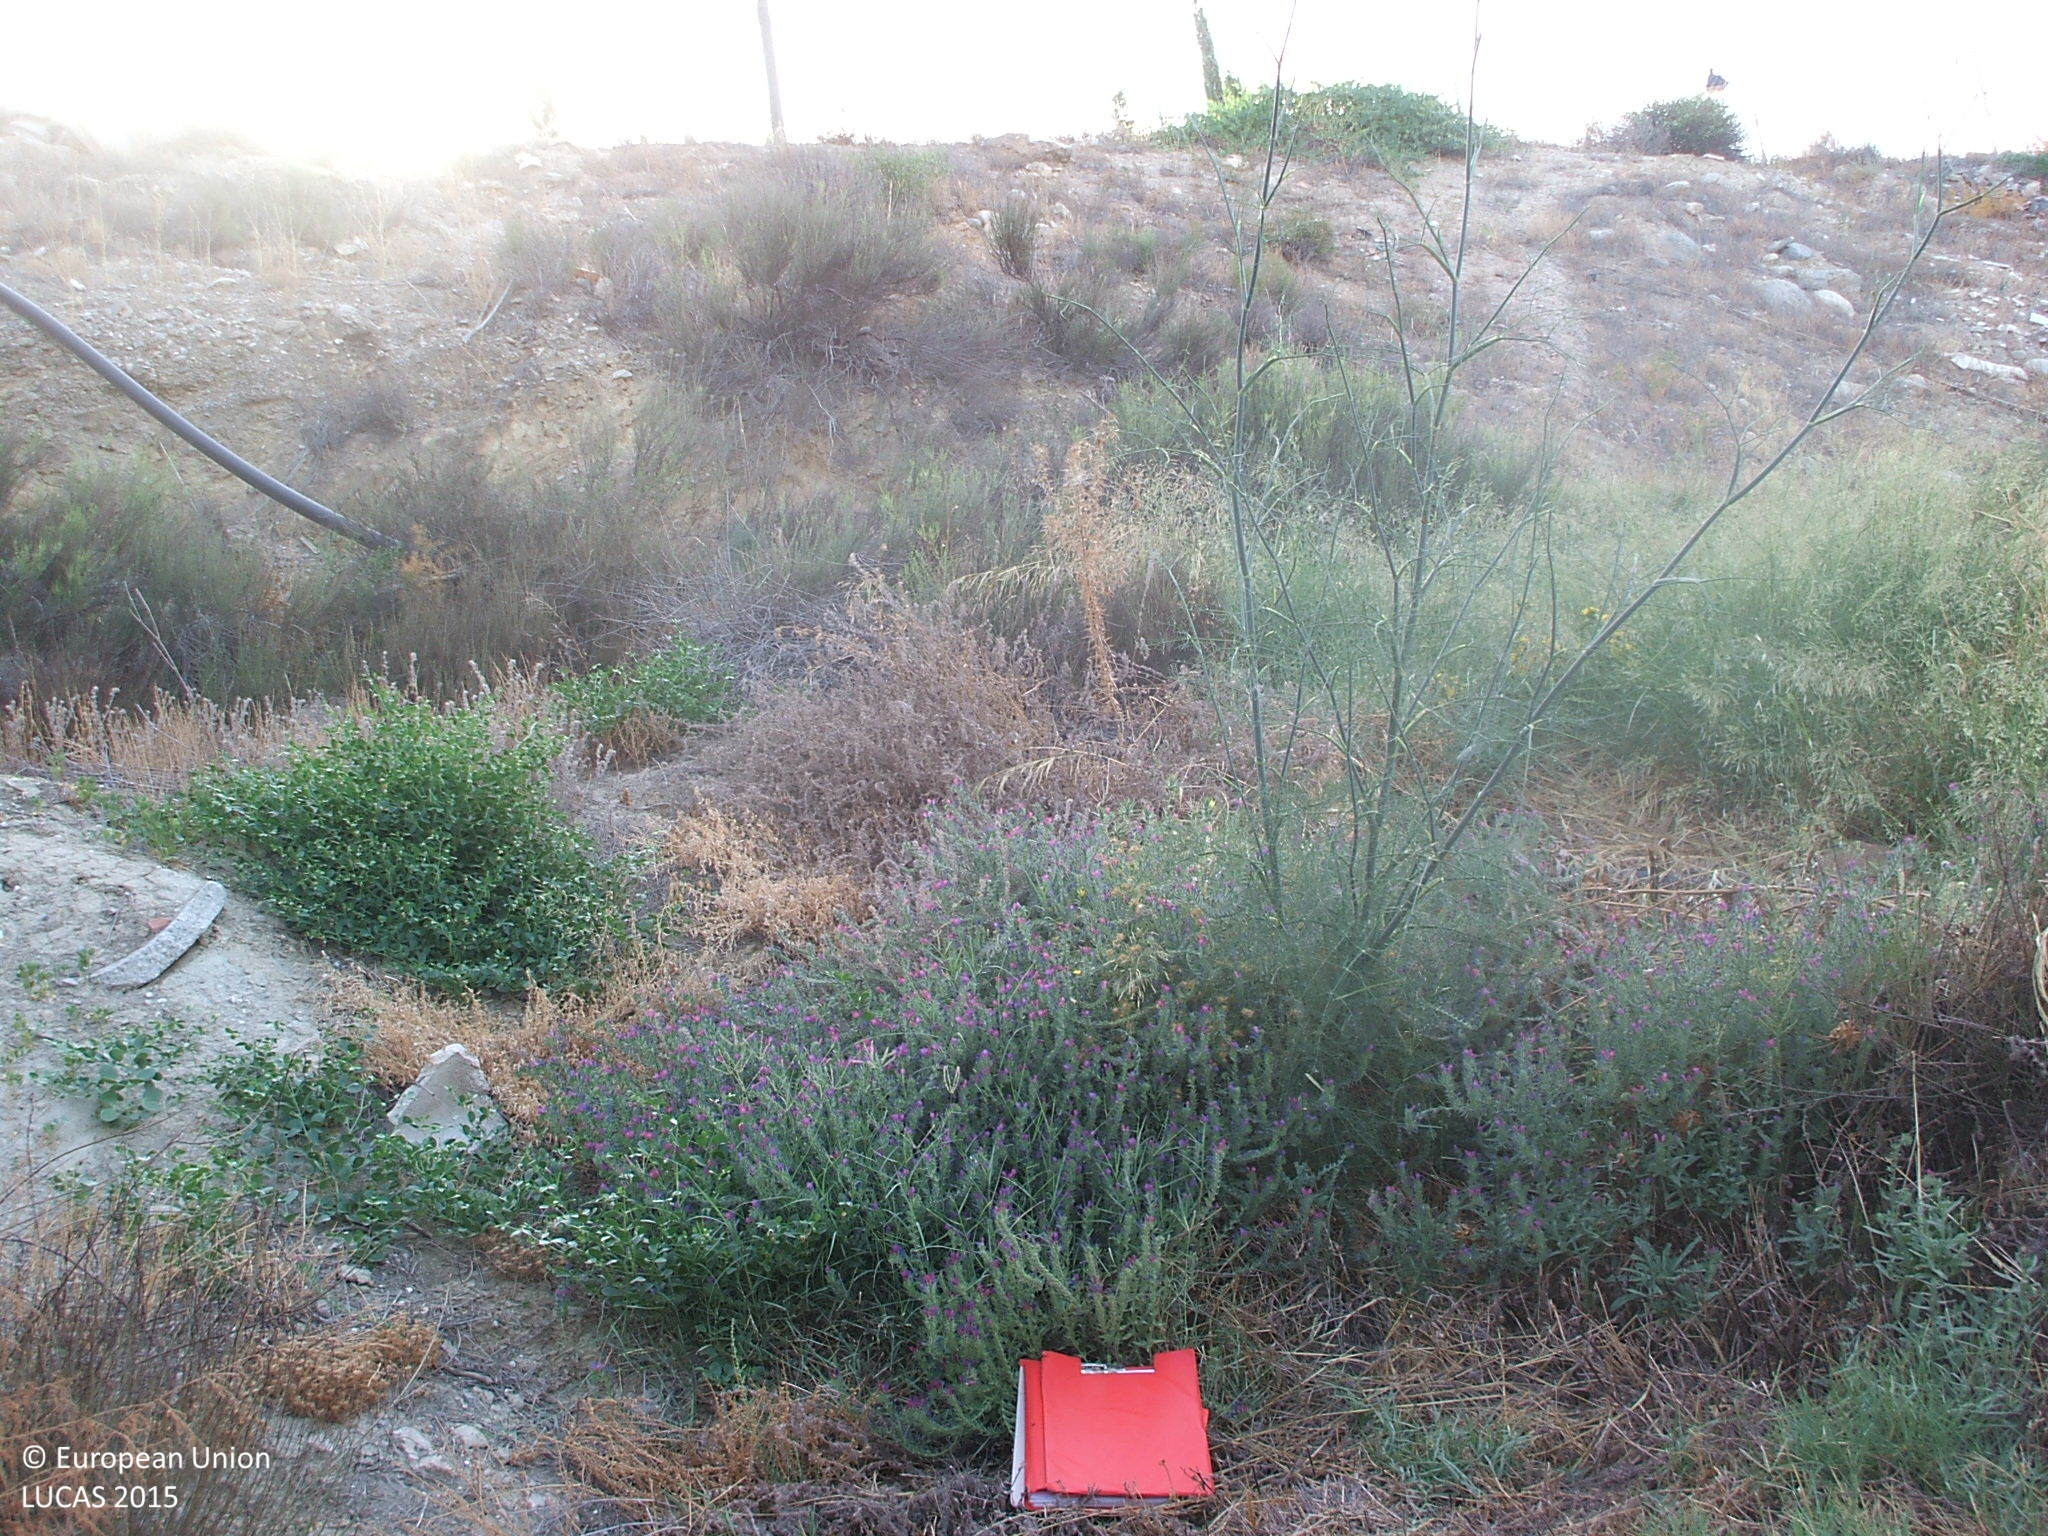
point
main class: Grassland
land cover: Grassland without tree/shrub cover
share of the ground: > 75 %
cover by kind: herbaceous plants 95 %, unconsolidated bare surface 5 %
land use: Semi-natural and natural areas not in use
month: July
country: ES
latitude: 37.3579
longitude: -2.2312
